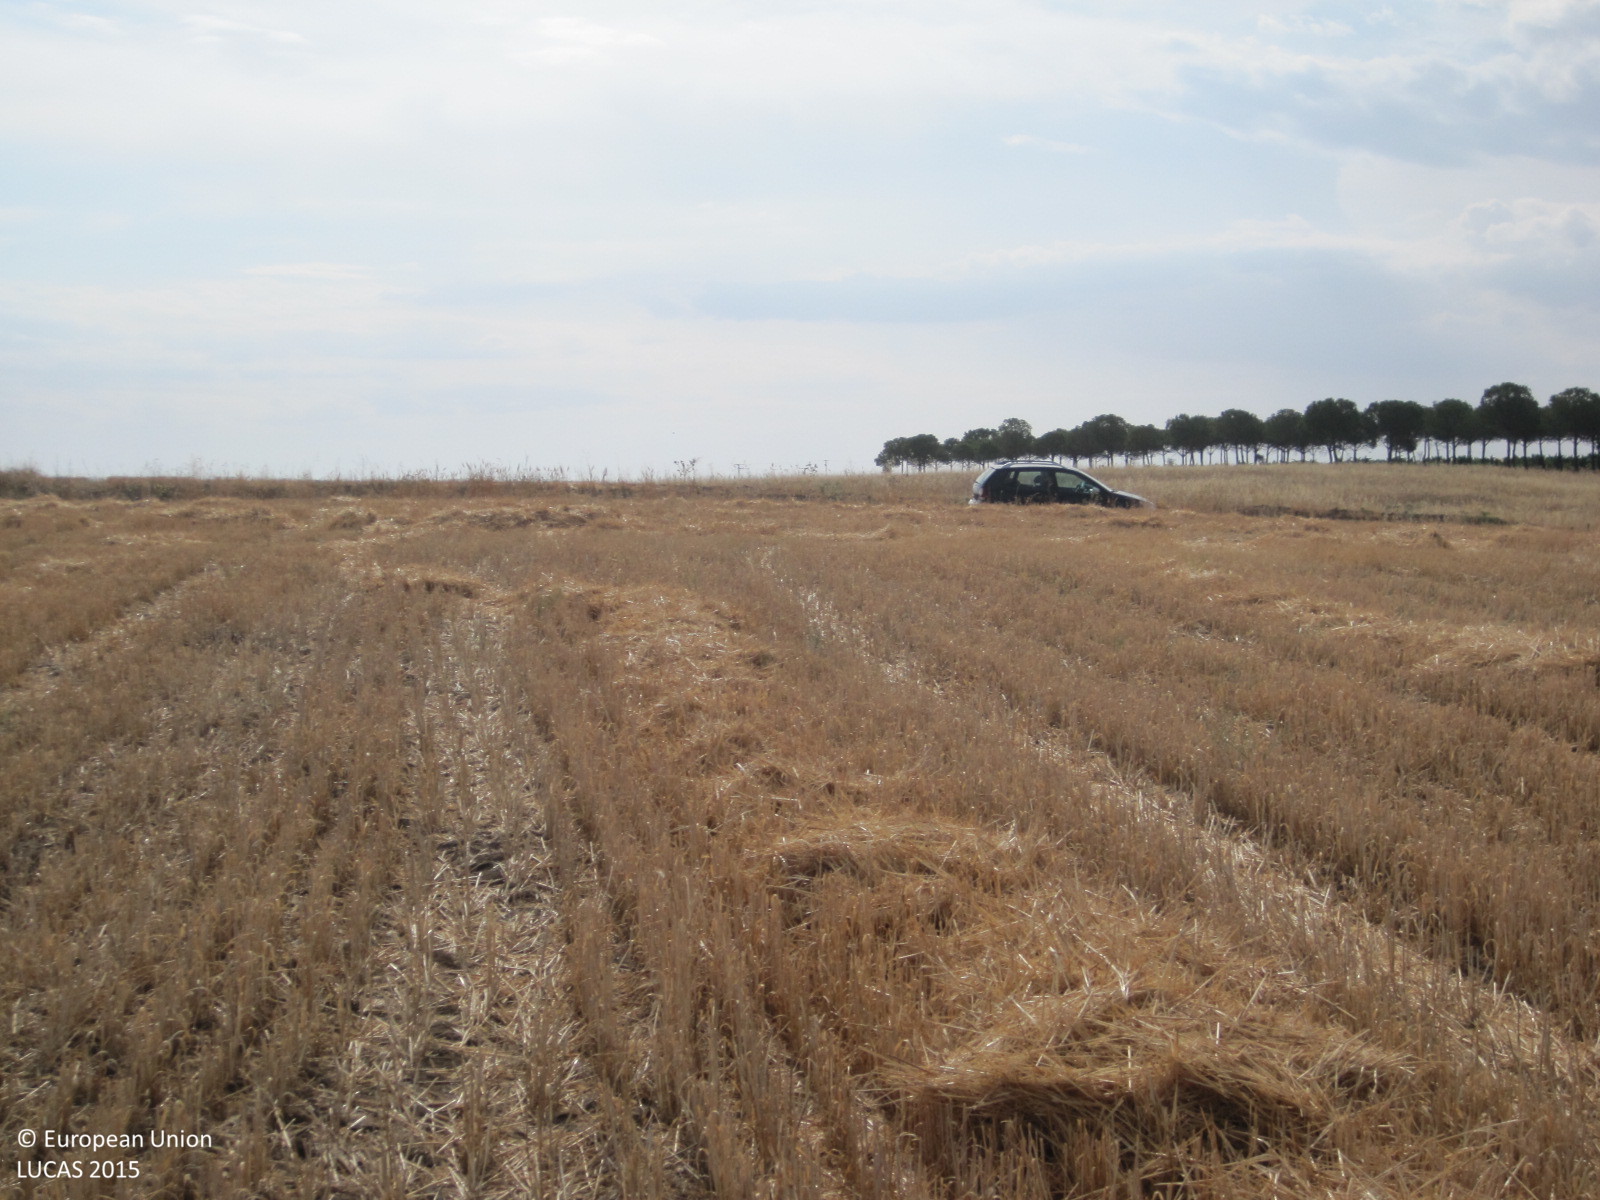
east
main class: Cropland
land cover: Common wheat
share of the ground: < 10 %
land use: Agriculture (excluding fallow land and kitchen gardens)
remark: Harvested field
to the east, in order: Common wheat; Grass margins; Tracks; Grass margins; Common wheat; Grass margins; Spontaneously vegetated surfaces
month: July
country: ES
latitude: 40.0487
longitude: -4.2348
